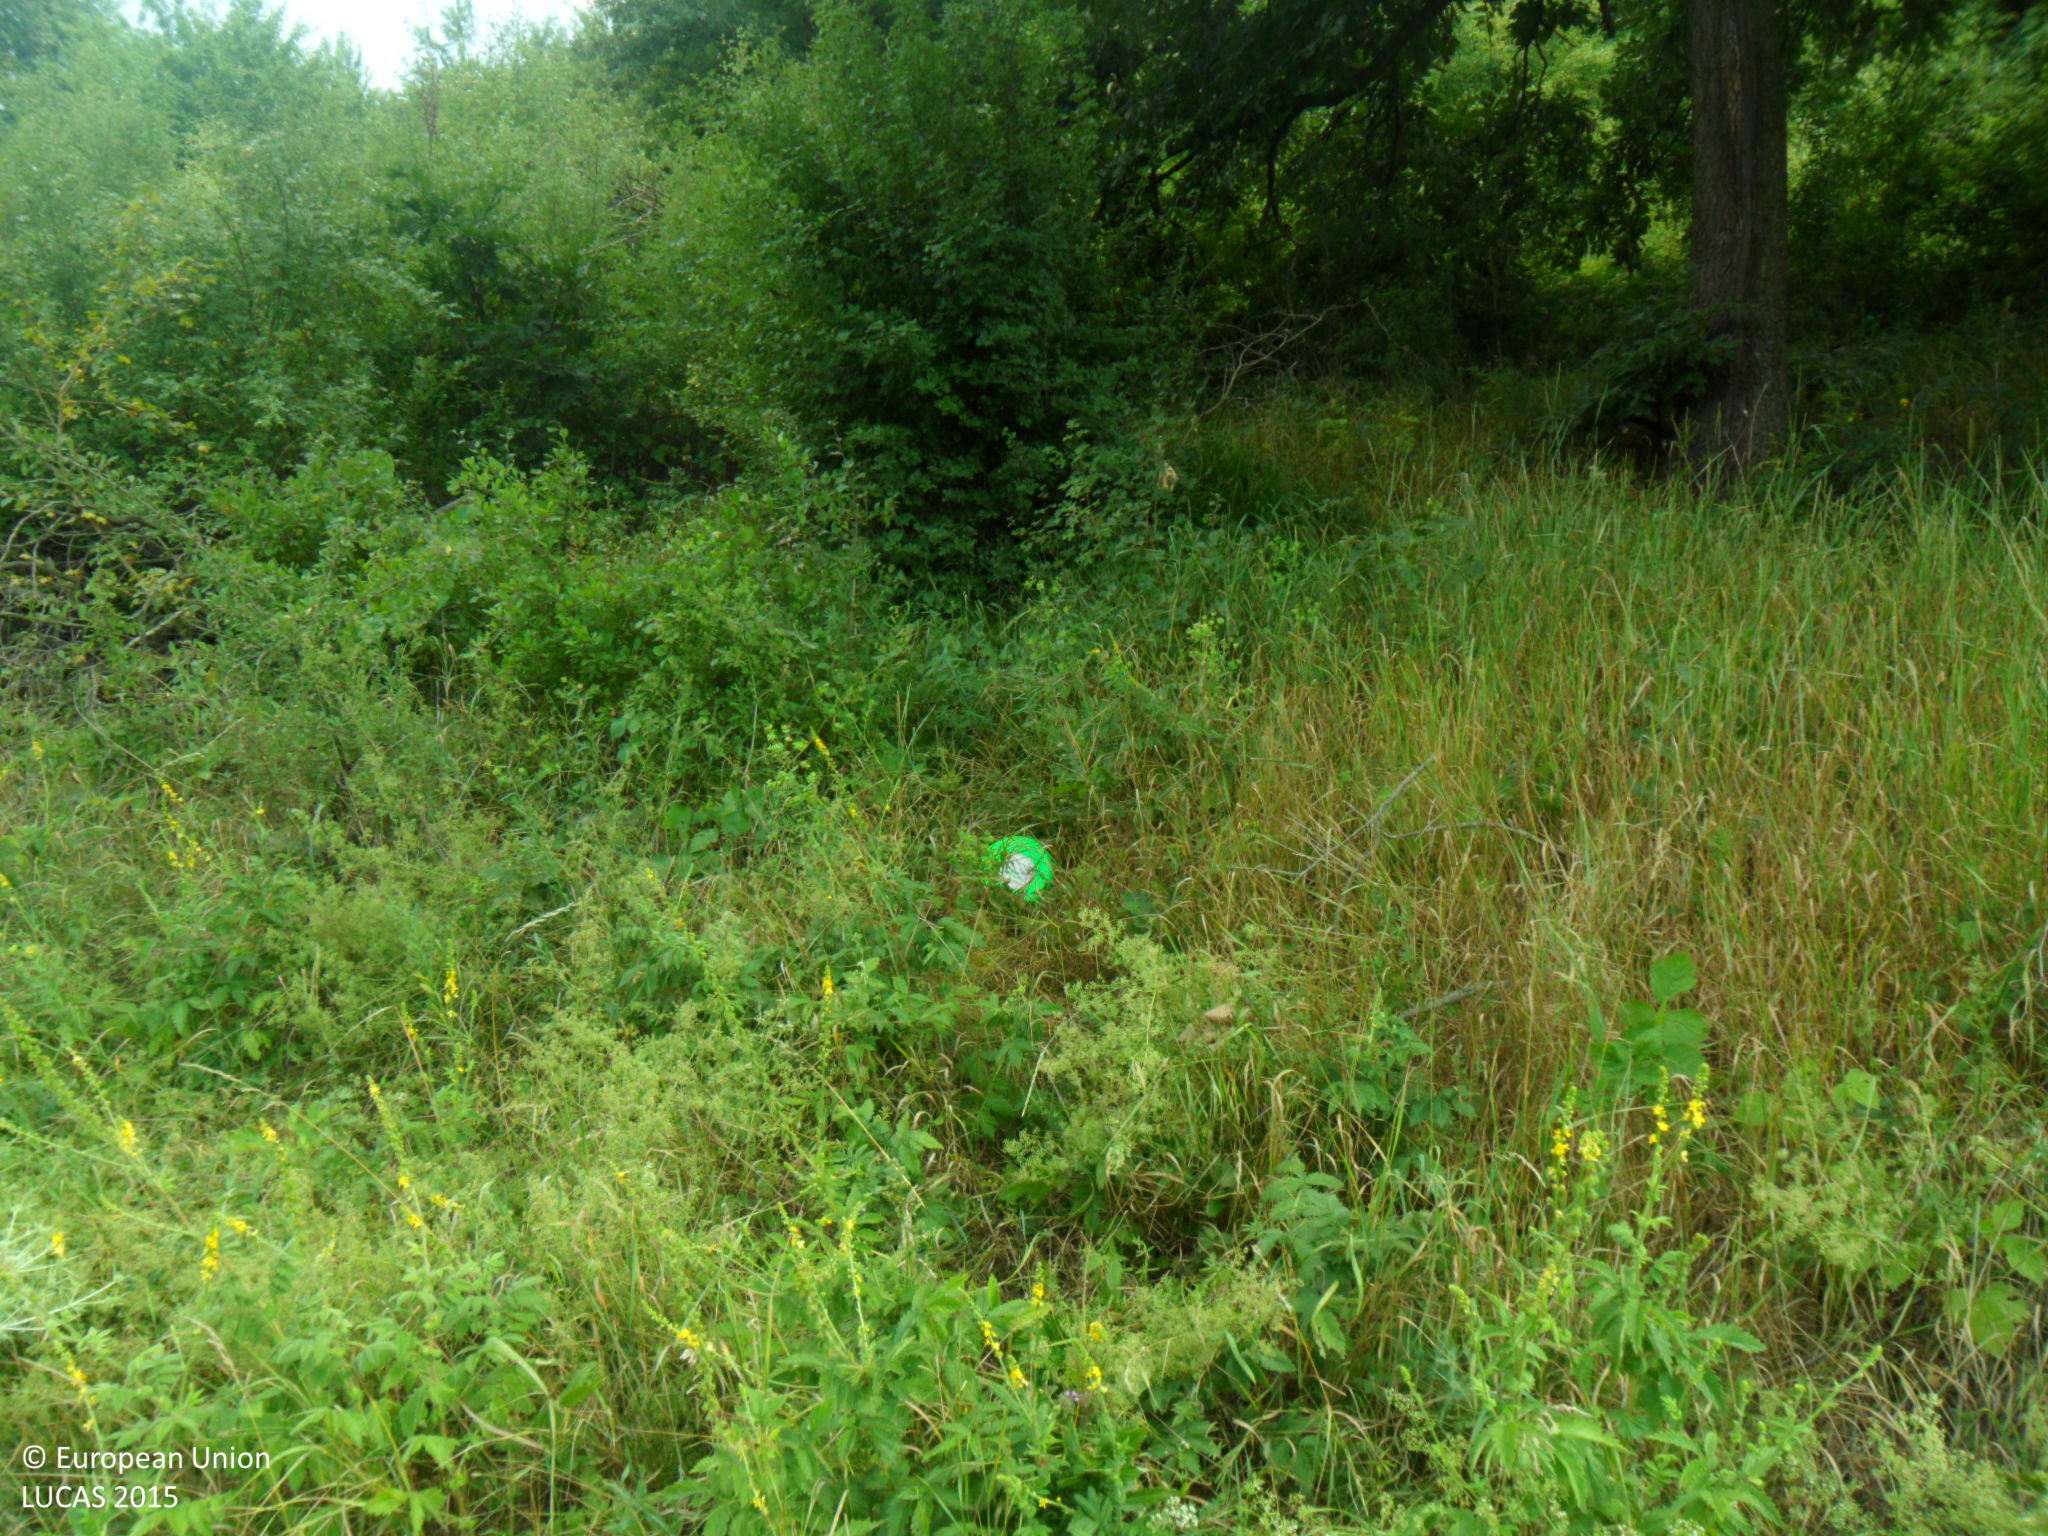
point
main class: Shrubland
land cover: Shrubland with sparse tree cover
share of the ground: > 75 %
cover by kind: shrubs 95 %, broadleaved forest trees 5 %
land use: Semi-natural and natural areas not in use
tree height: > 5 m
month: July
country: BG
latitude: 43.5821
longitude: 27.2017
